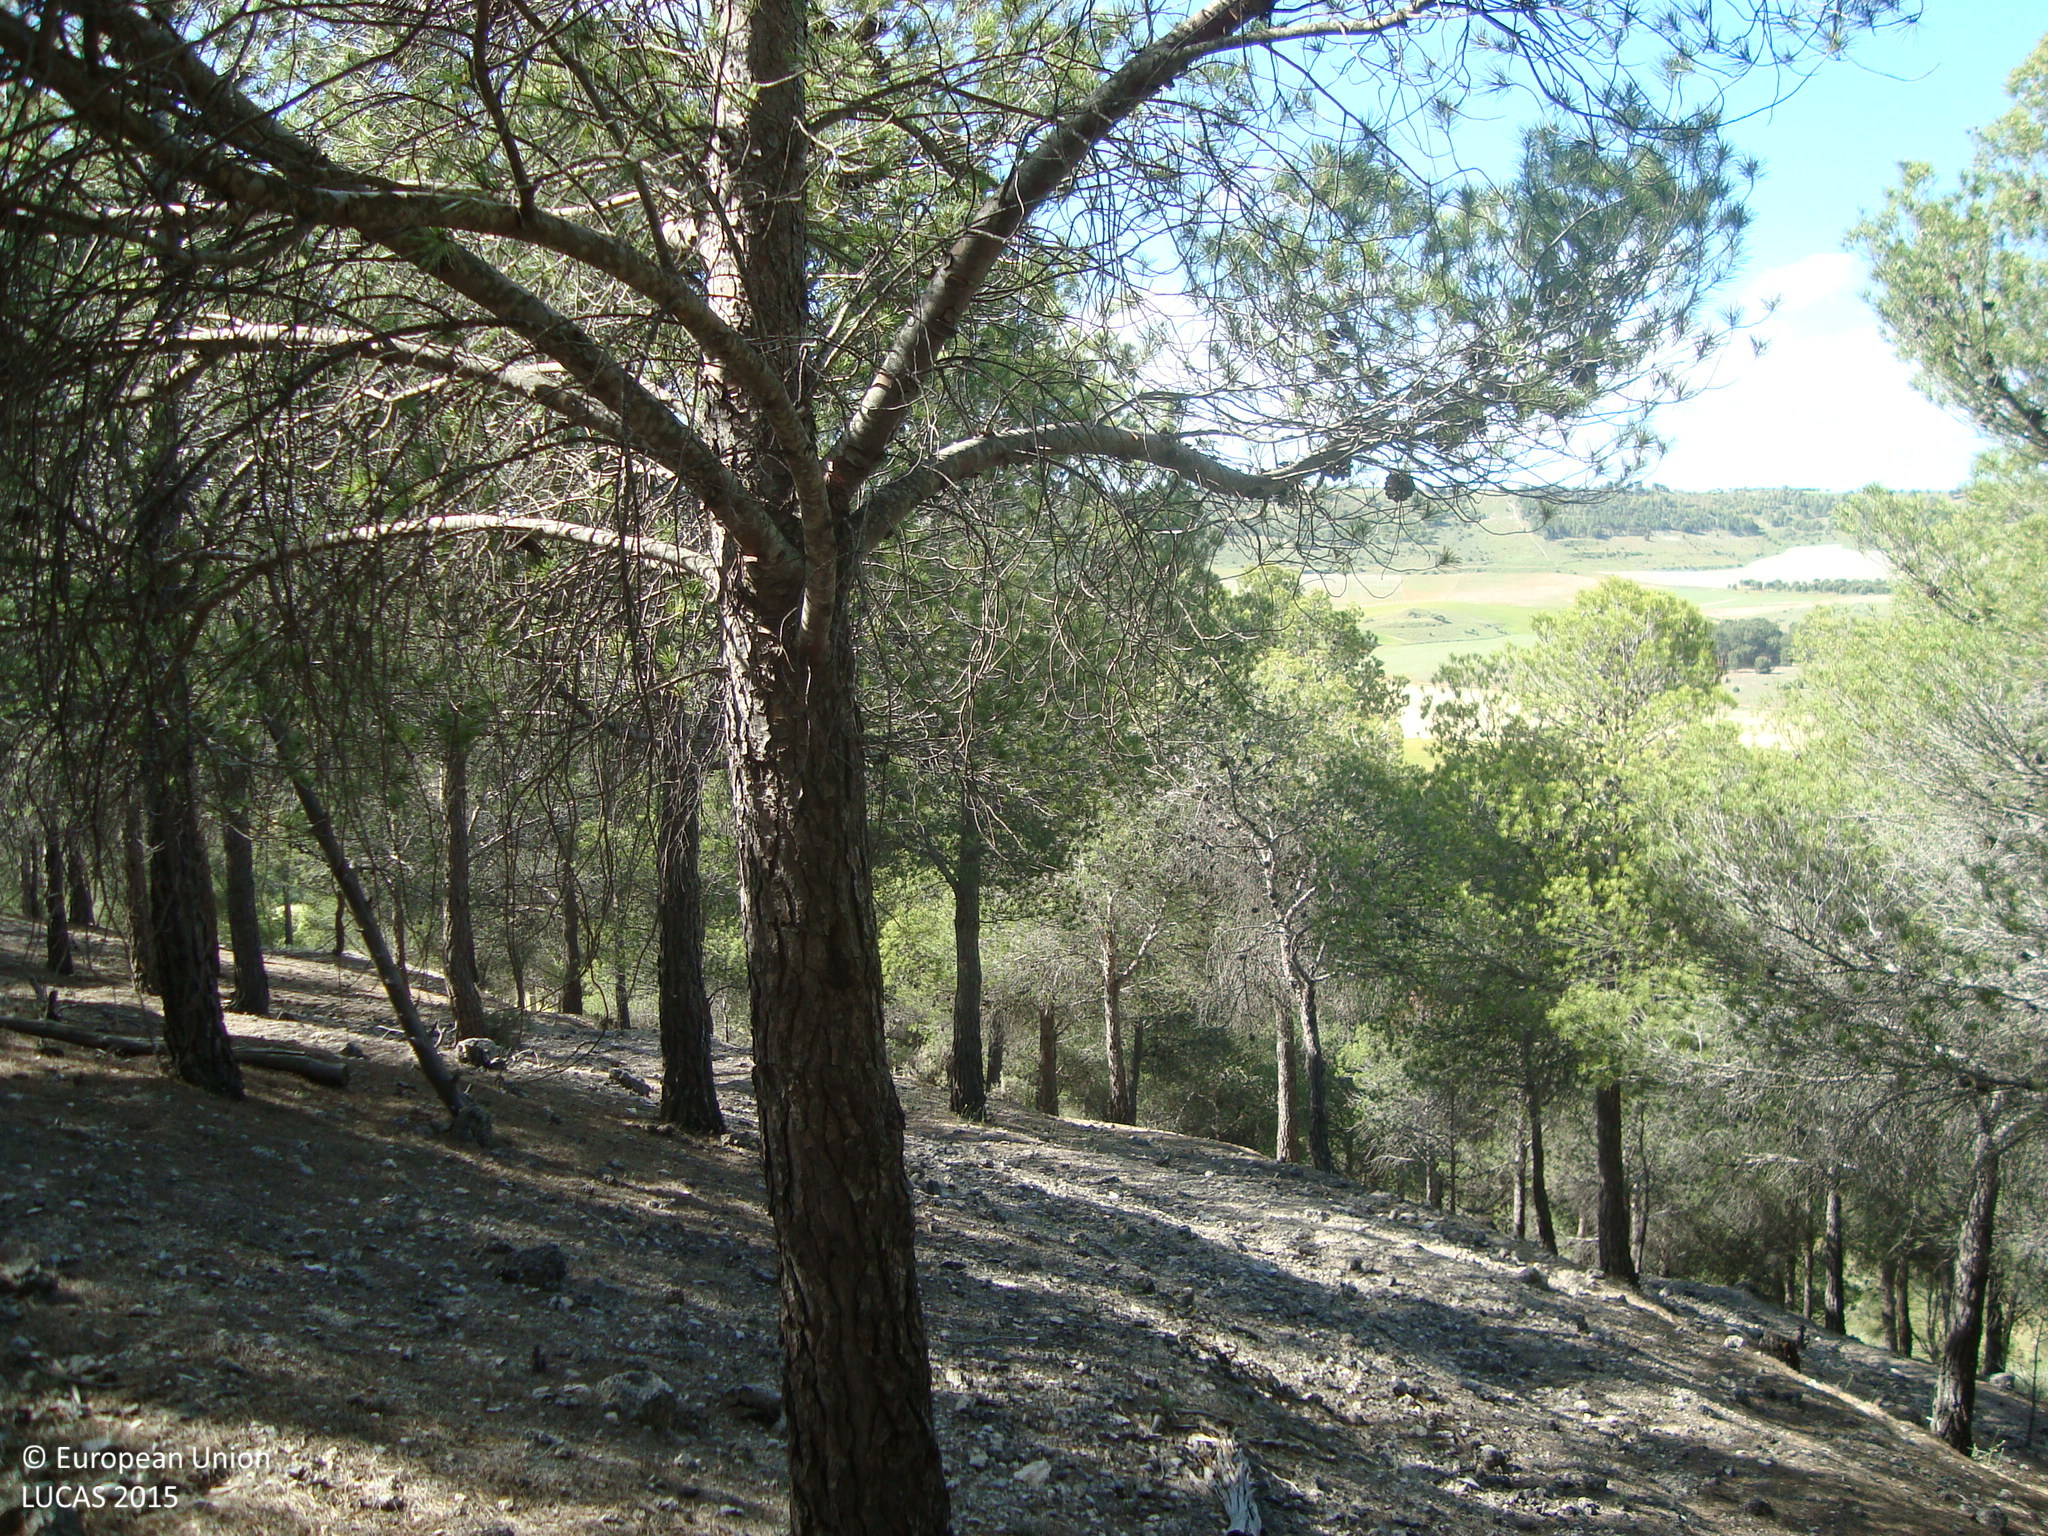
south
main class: Woodland
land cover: Pine dominated coniferous woodland
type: coniferous forest of the mediterranean region
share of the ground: > 75 %
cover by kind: coniferous forest trees 80 %, unconsolidated bare surface 10 %, shrubs 5 %, herbaceous plants 5 %
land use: Forestry
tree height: > 5 m
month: May
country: ES
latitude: 41.4208
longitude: -4.6258
